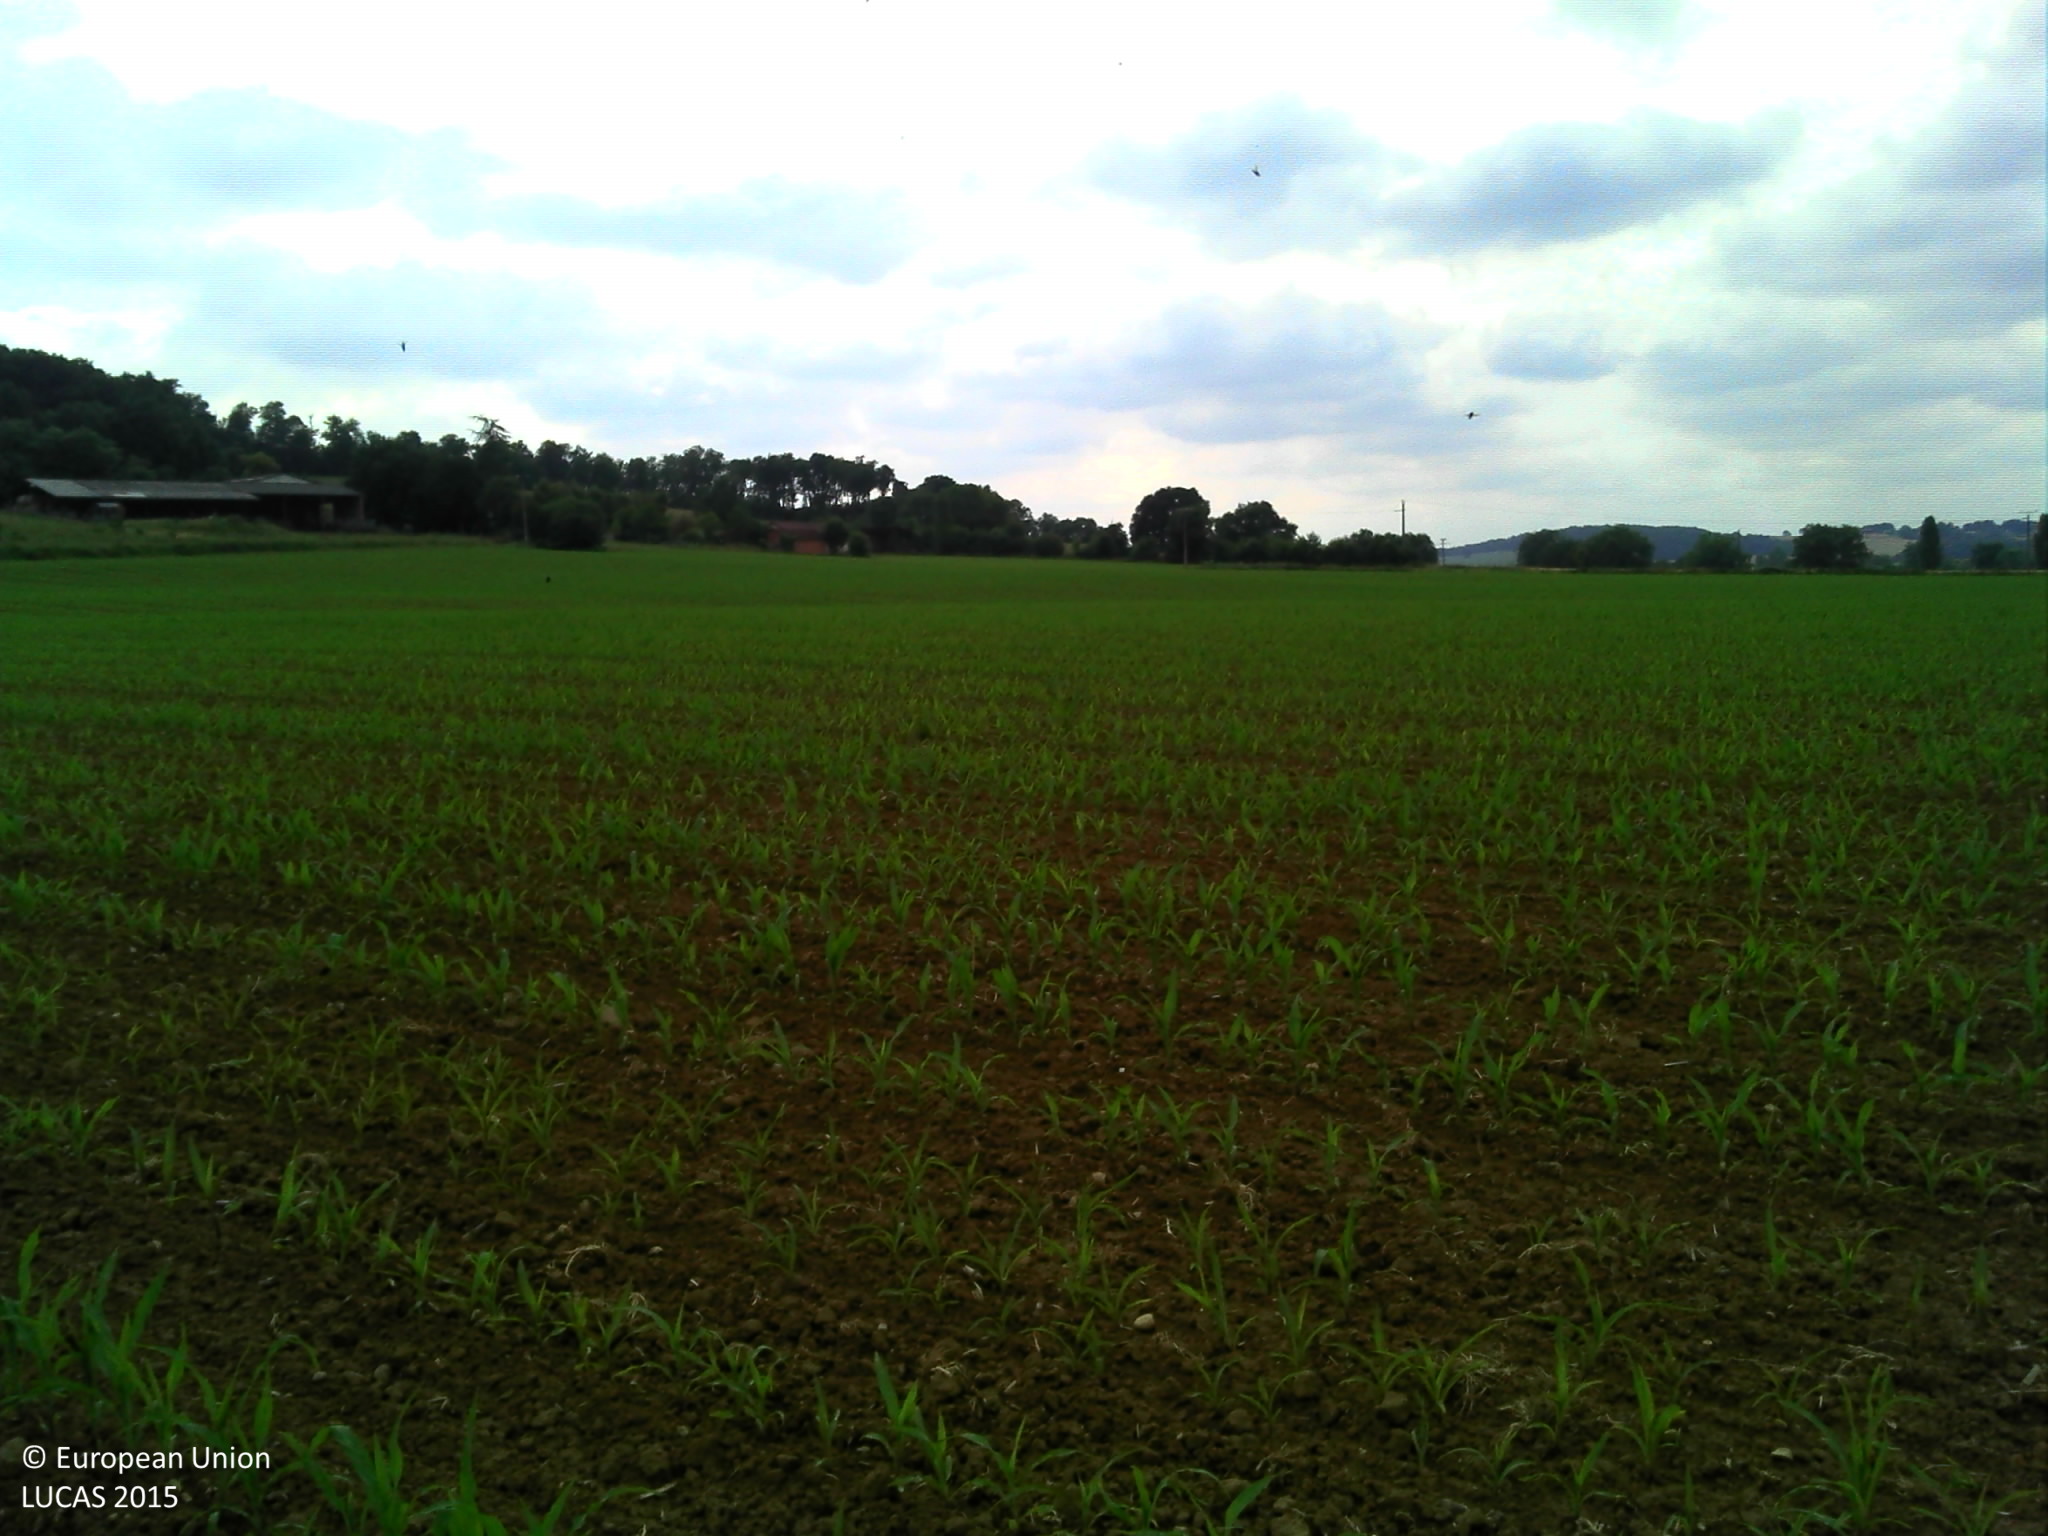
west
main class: Cropland
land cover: Maize
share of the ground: 10 - 25 %
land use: Agriculture (excluding fallow land and kitchen gardens)
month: June
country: FR
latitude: 43.6100
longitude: -0.2046
